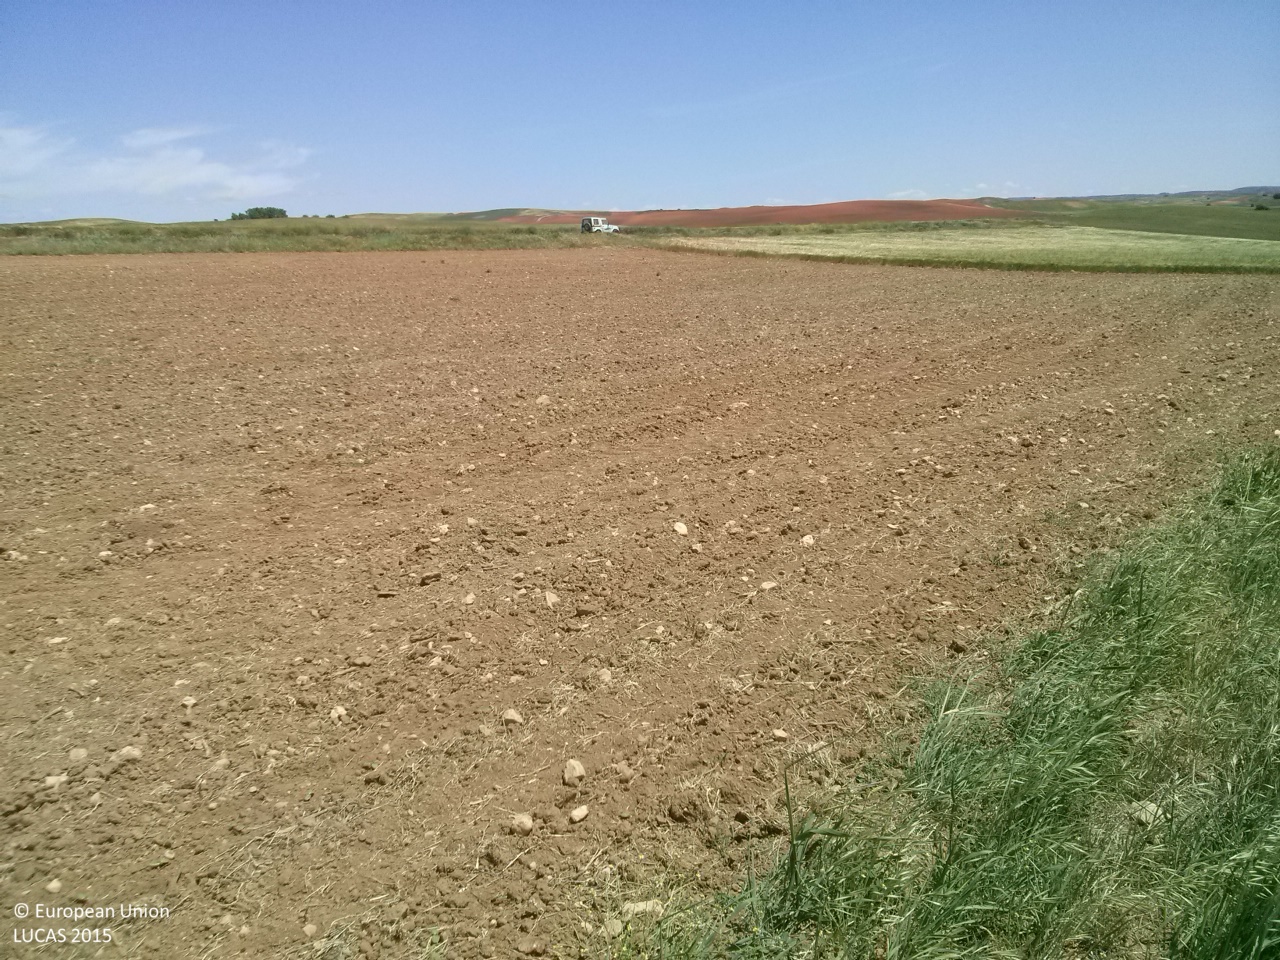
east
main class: Cropland
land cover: Sunflower
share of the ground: < 10 %
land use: Agriculture (excluding fallow land and kitchen gardens)
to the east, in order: Grass margins; Sunflower; Barley; Grass margins; Tracks; Grass margins; Barley; Common wheat
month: May
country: ES
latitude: 40.1201
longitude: -2.8011
